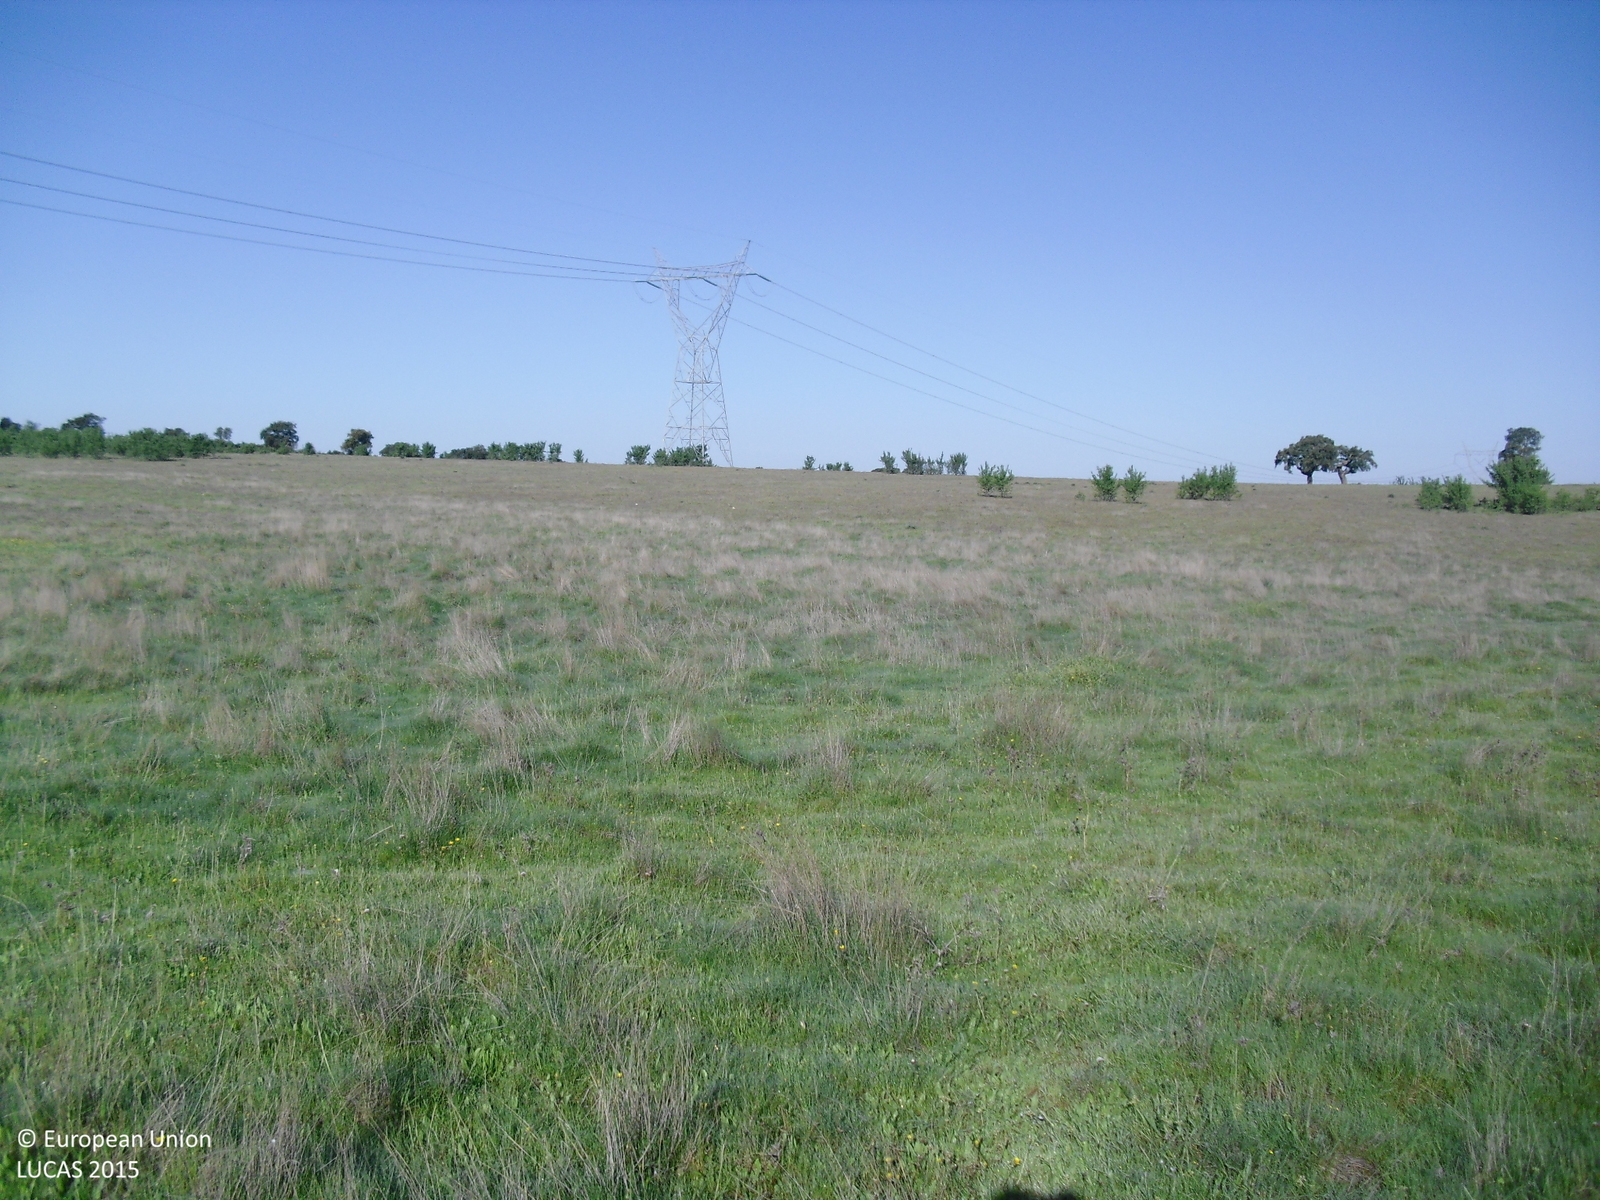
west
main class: Grassland
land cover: Grassland with sparse tree/shrub cover
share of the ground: > 75 %
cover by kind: herbaceous plants 90 %, broadleaved forest trees 5 %, shrubs 5 %
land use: Agriculture (excluding fallow land and kitchen gardens)
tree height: < 5 m
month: April
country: ES
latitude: 39.6284
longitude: -7.4656
